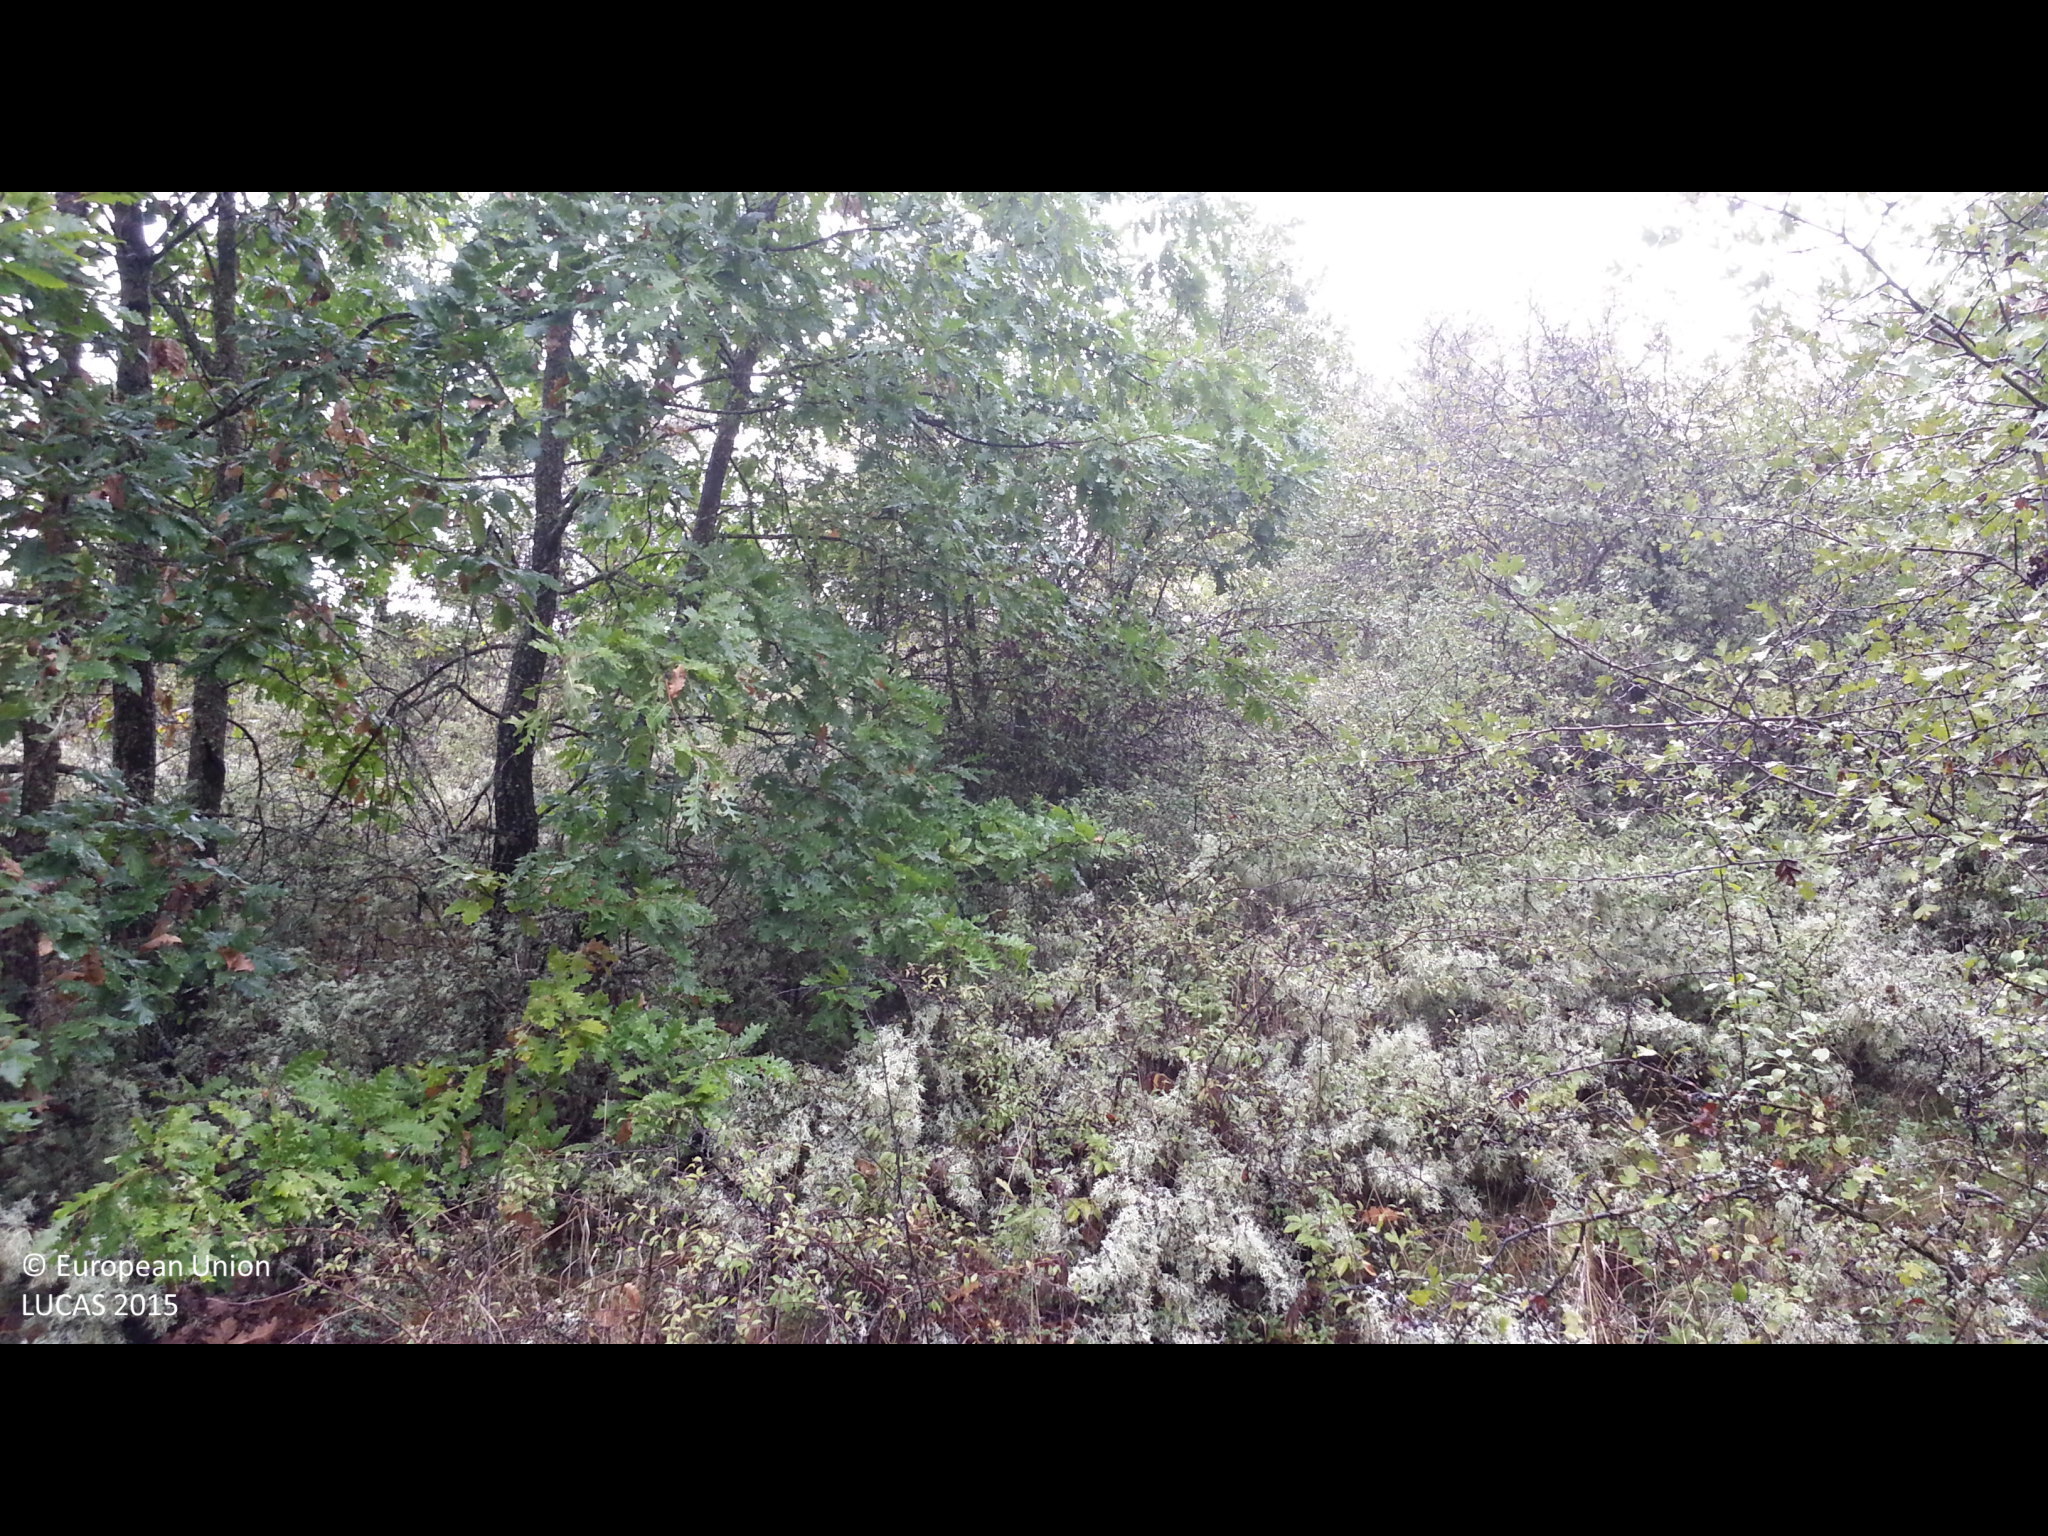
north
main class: Shrubland
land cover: Shrubland with sparse tree cover
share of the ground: > 75 %
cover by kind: shrubs 95 %, broadleaved forest trees 5 %
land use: Semi-natural and natural areas not in use
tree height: < 5 m
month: September
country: BG
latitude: 42.5031
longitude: 22.7412
